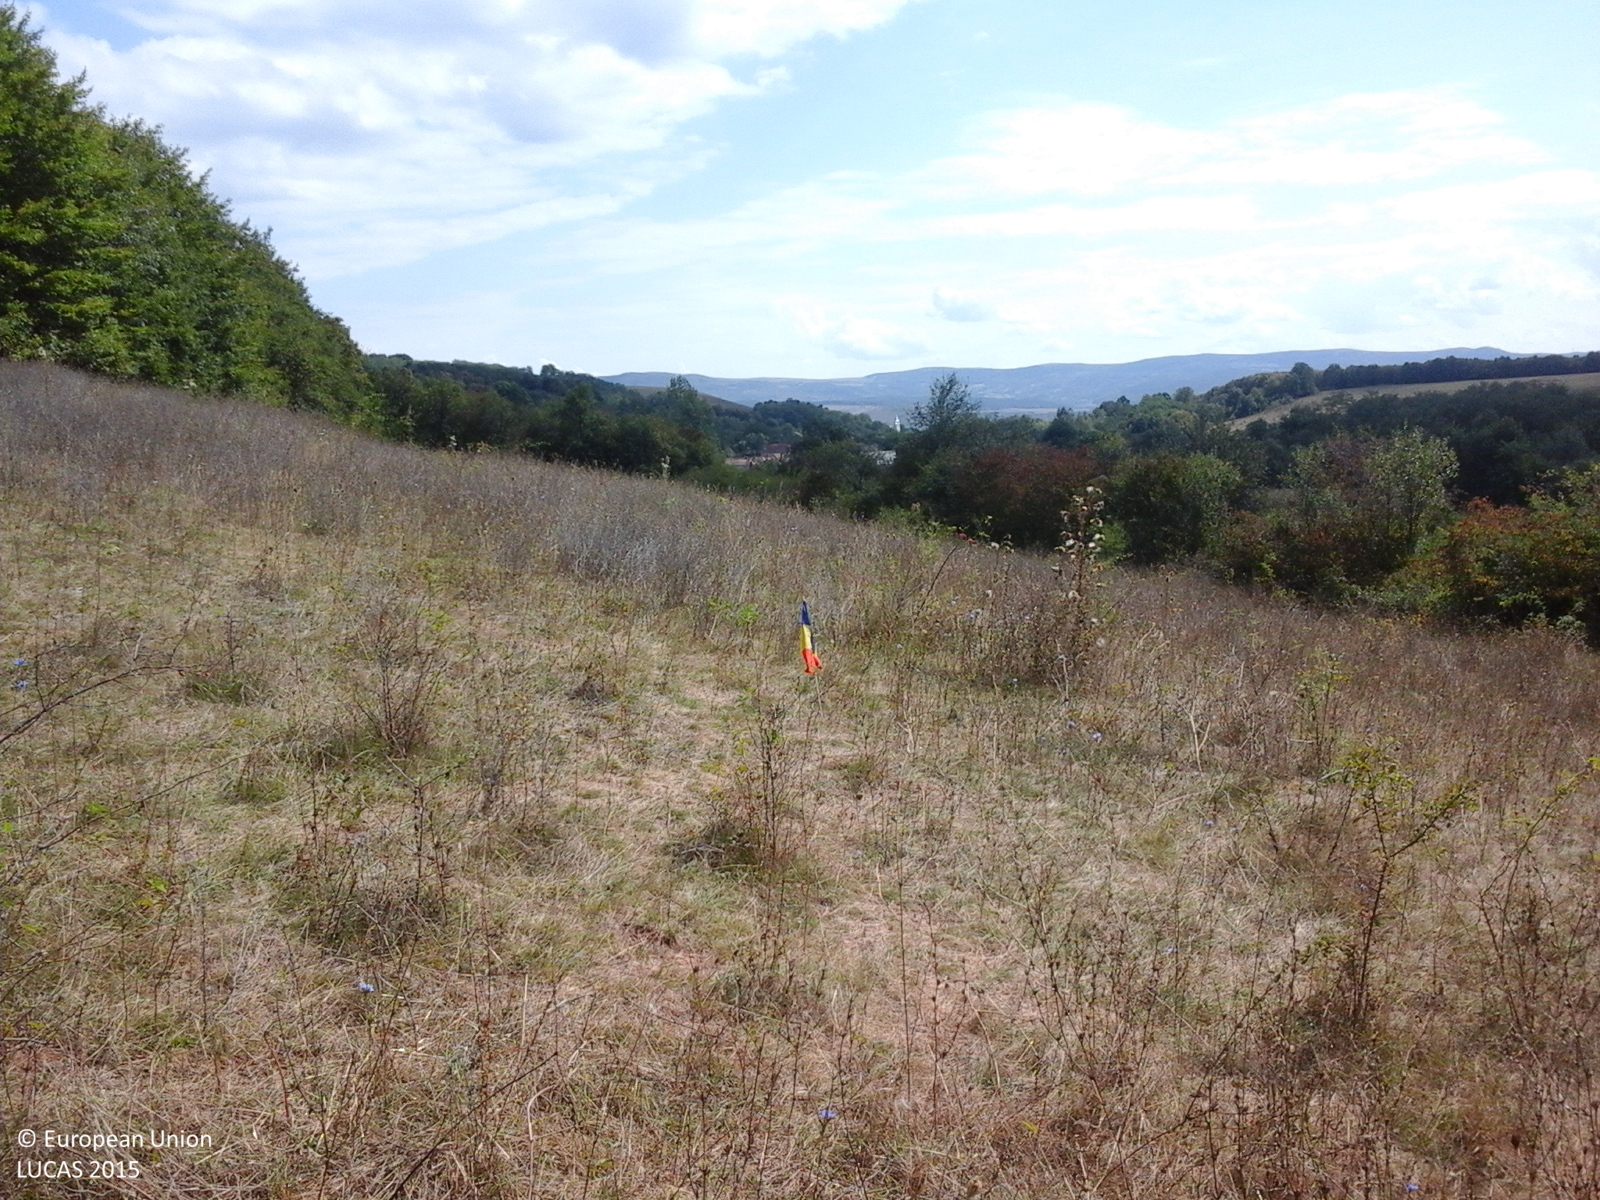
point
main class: Grassland
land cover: Grassland with sparse tree/shrub cover
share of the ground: > 75 %
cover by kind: herbaceous plants 95 %, broadleaved forest trees 5 %
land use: Agriculture (excluding fallow land and kitchen gardens)
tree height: > 5 m
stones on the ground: < 10 %
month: September
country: RO
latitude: 47.3655
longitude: 23.2438
